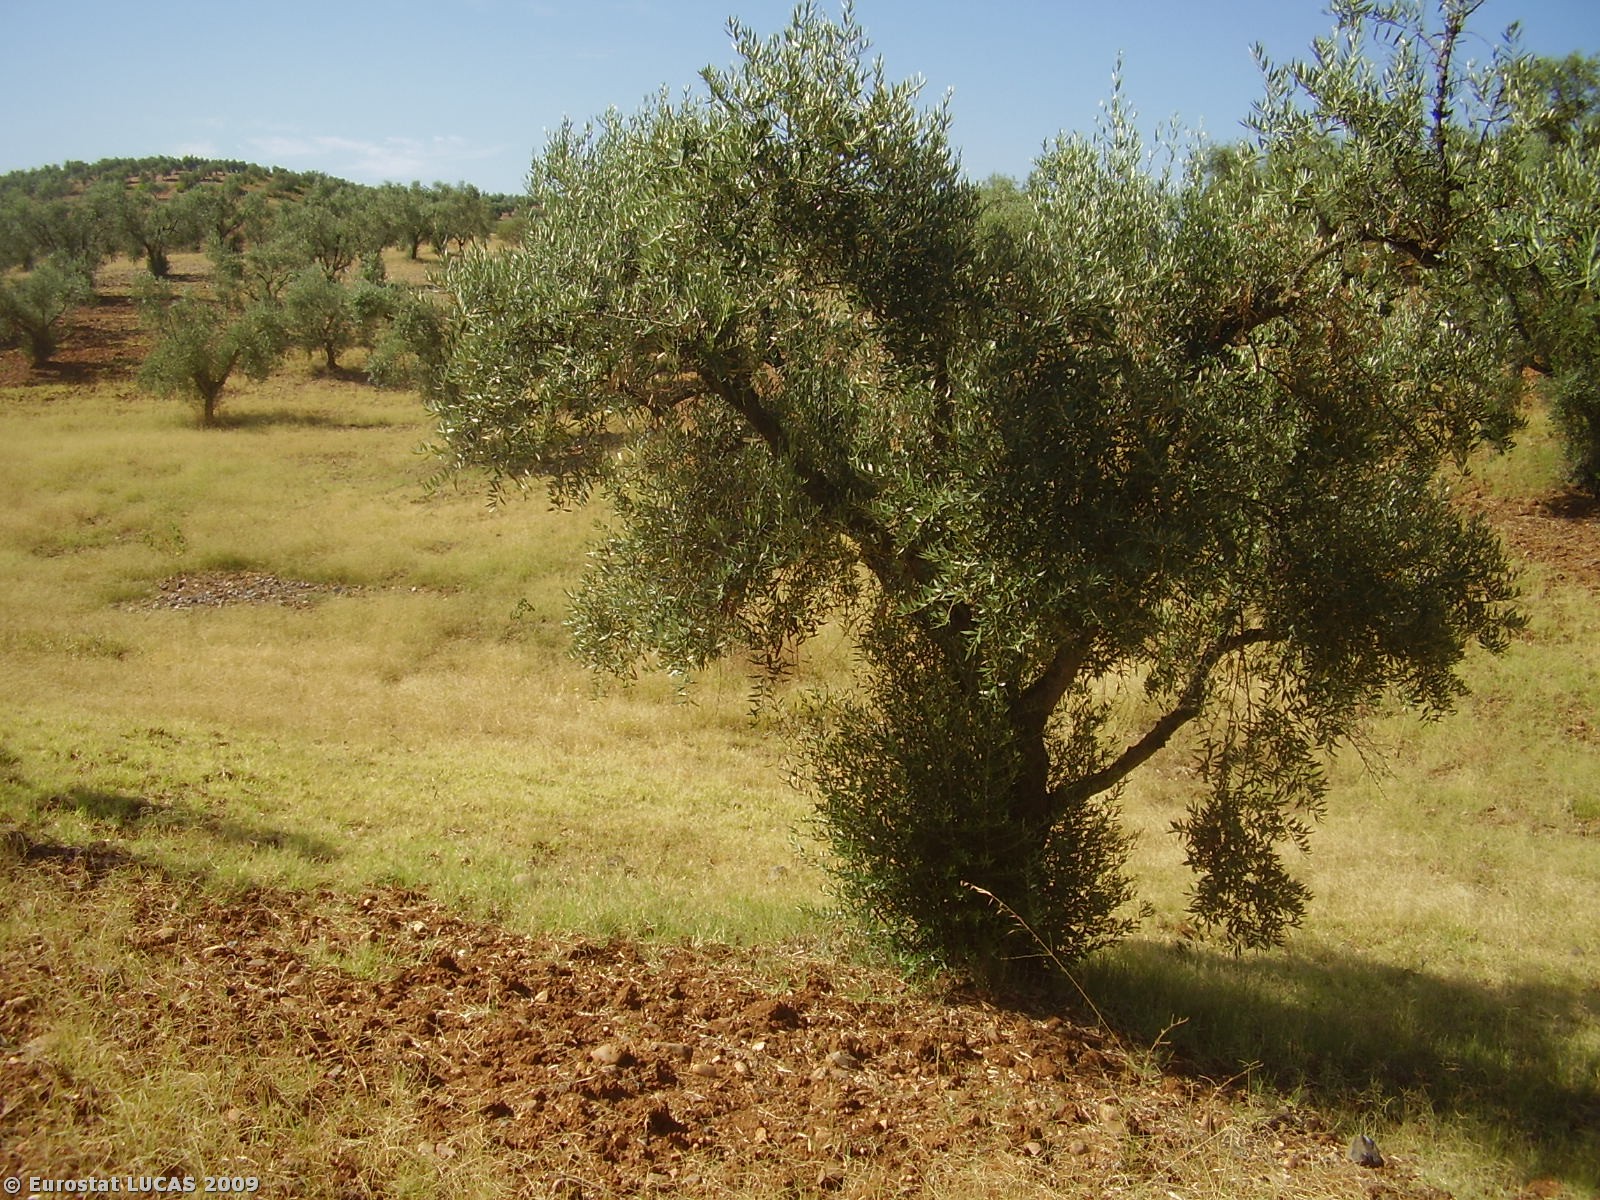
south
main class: Cropland
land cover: Olive groves
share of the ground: 10 - 25 %
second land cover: Spontaneously vegetated surfaces
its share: 50 - 75 %
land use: Agriculture (excluding fallow land and kitchen gardens)
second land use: Fallow land
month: August
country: PT
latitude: 38.1258
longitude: -7.6028
